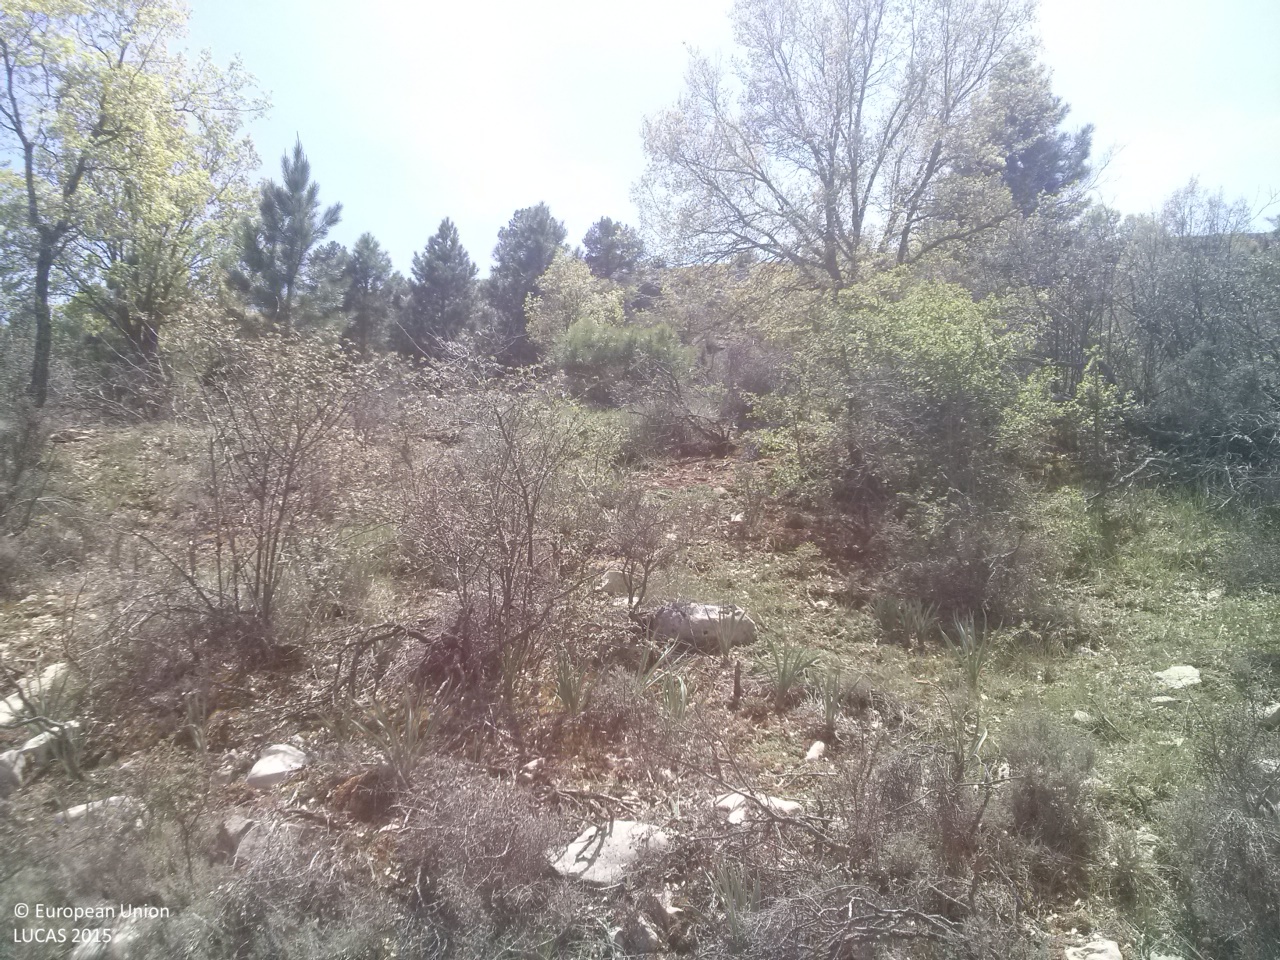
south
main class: Woodland
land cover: Other mixed woodland
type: thermophilous deciduous forest
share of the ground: 10 - 25 %
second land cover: Shrubland without tree cover
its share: 50 - 75 %
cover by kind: shrubs 40 %, herbaceous plants 35 %, broadleaved forest trees 15 %, coniferous forest trees 5 %, unconsolidated bare surface 5 %
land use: Forestry
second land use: Agriculture (excluding fallow land and kitchen gardens)
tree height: > 5 m
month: April
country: ES
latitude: 40.0125
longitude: -1.6208
